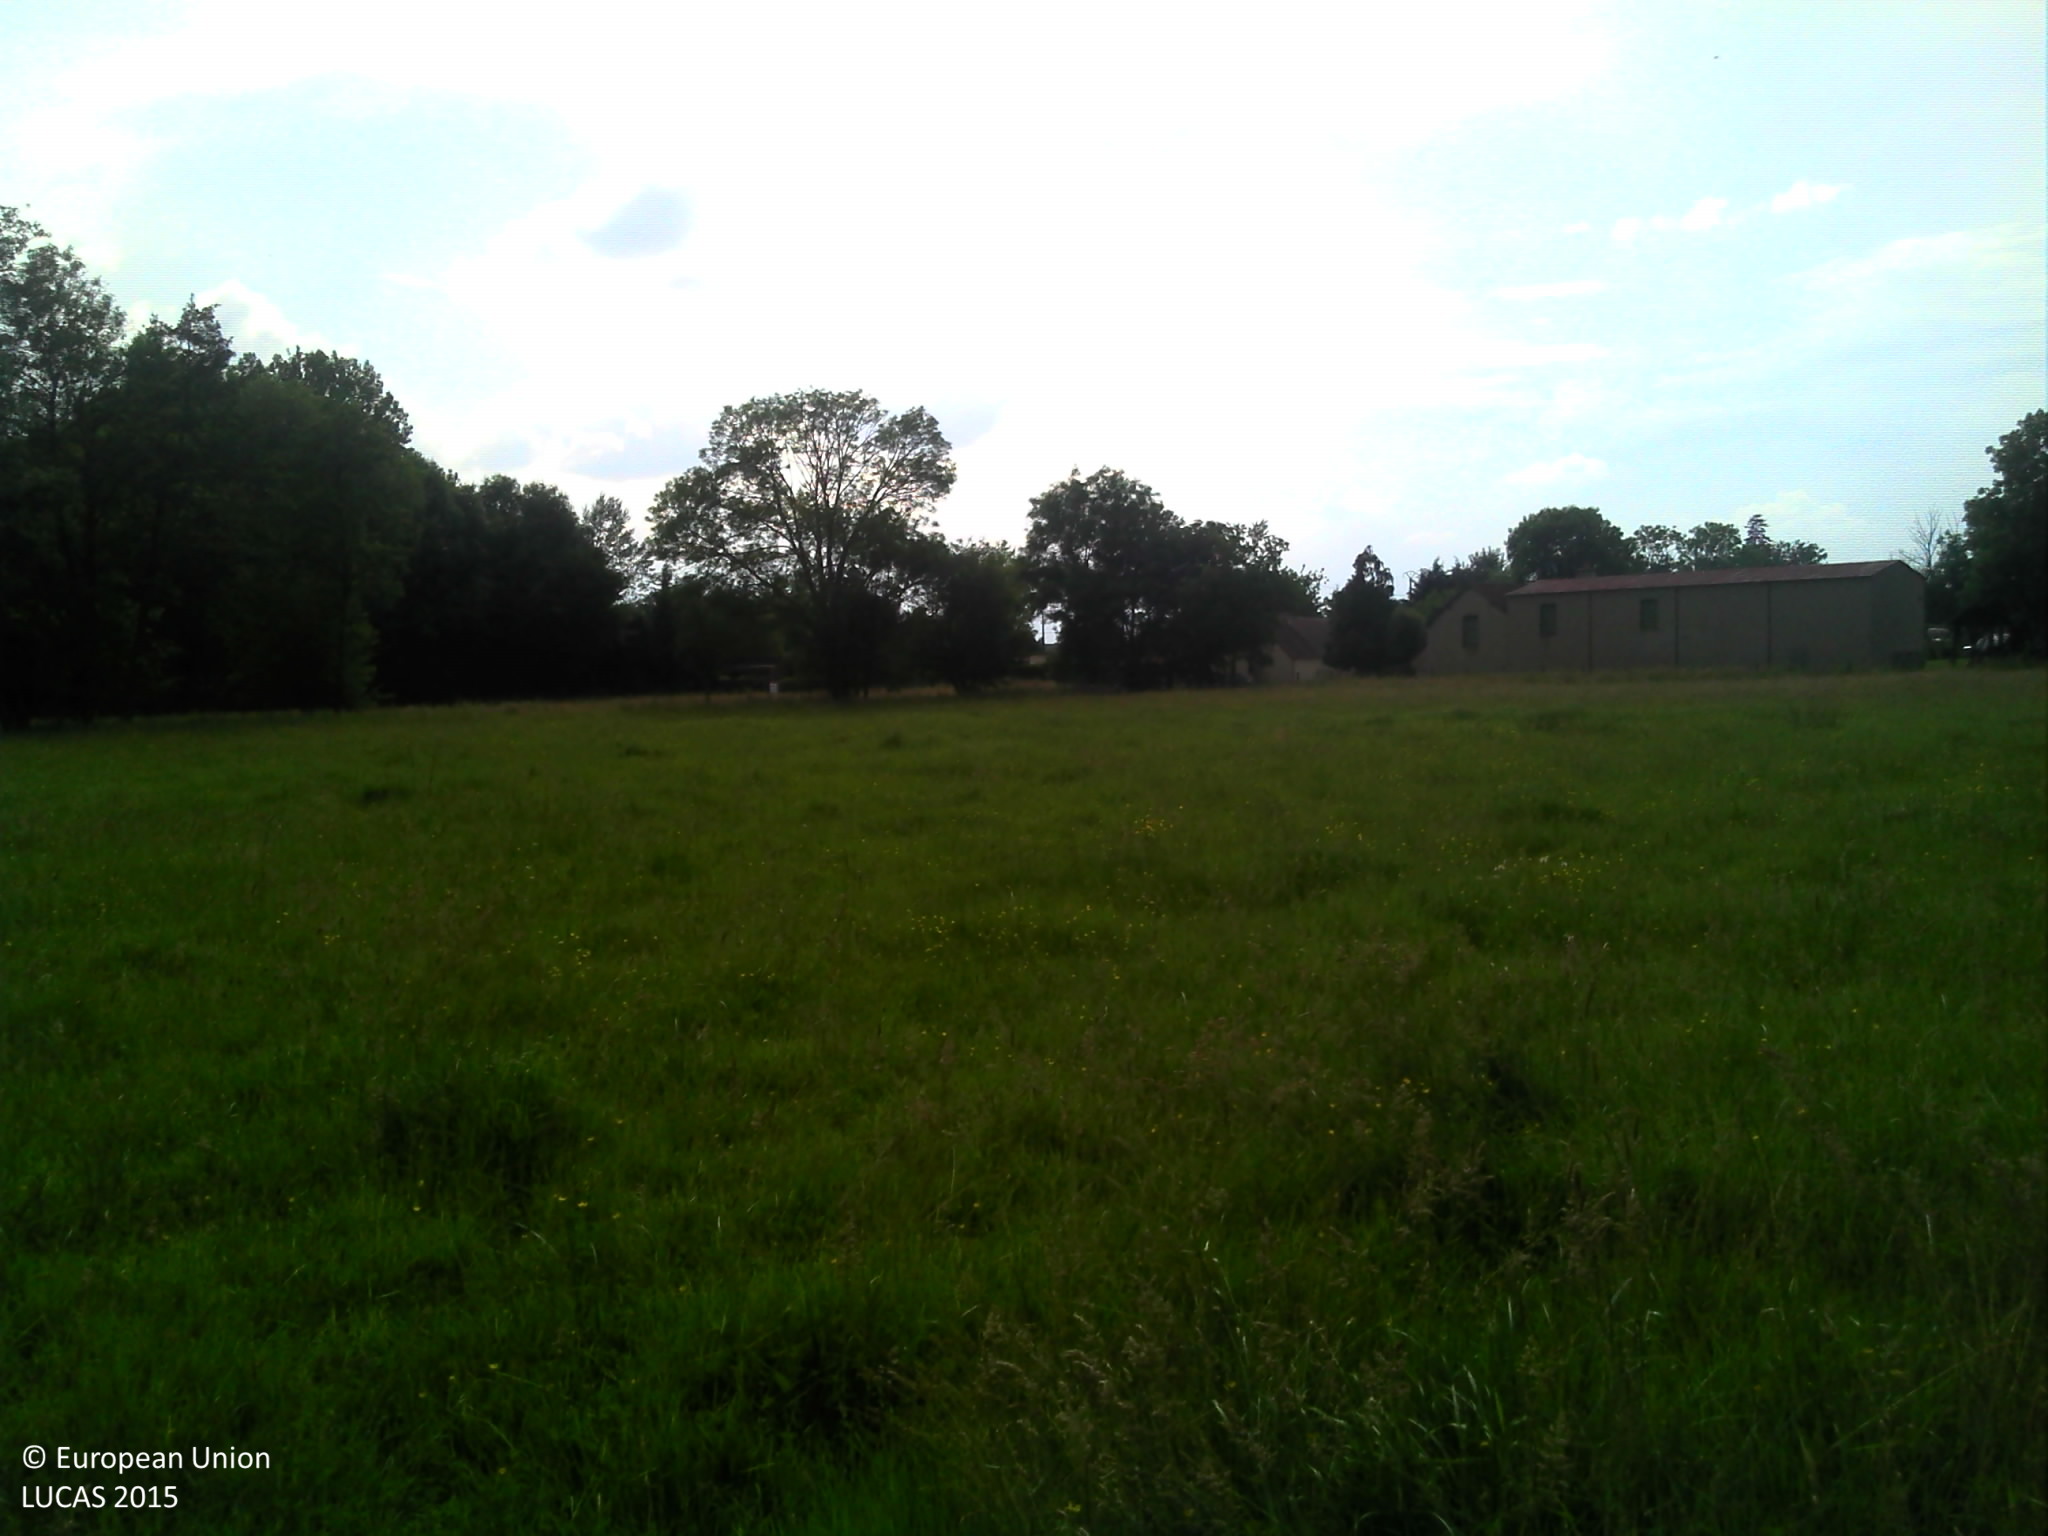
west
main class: Grassland
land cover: Grassland without tree/shrub cover
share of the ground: > 75 %
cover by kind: herbaceous plants 100 %
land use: Agriculture (excluding fallow land and kitchen gardens)
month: June
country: FR
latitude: 48.4763
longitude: 0.2194
